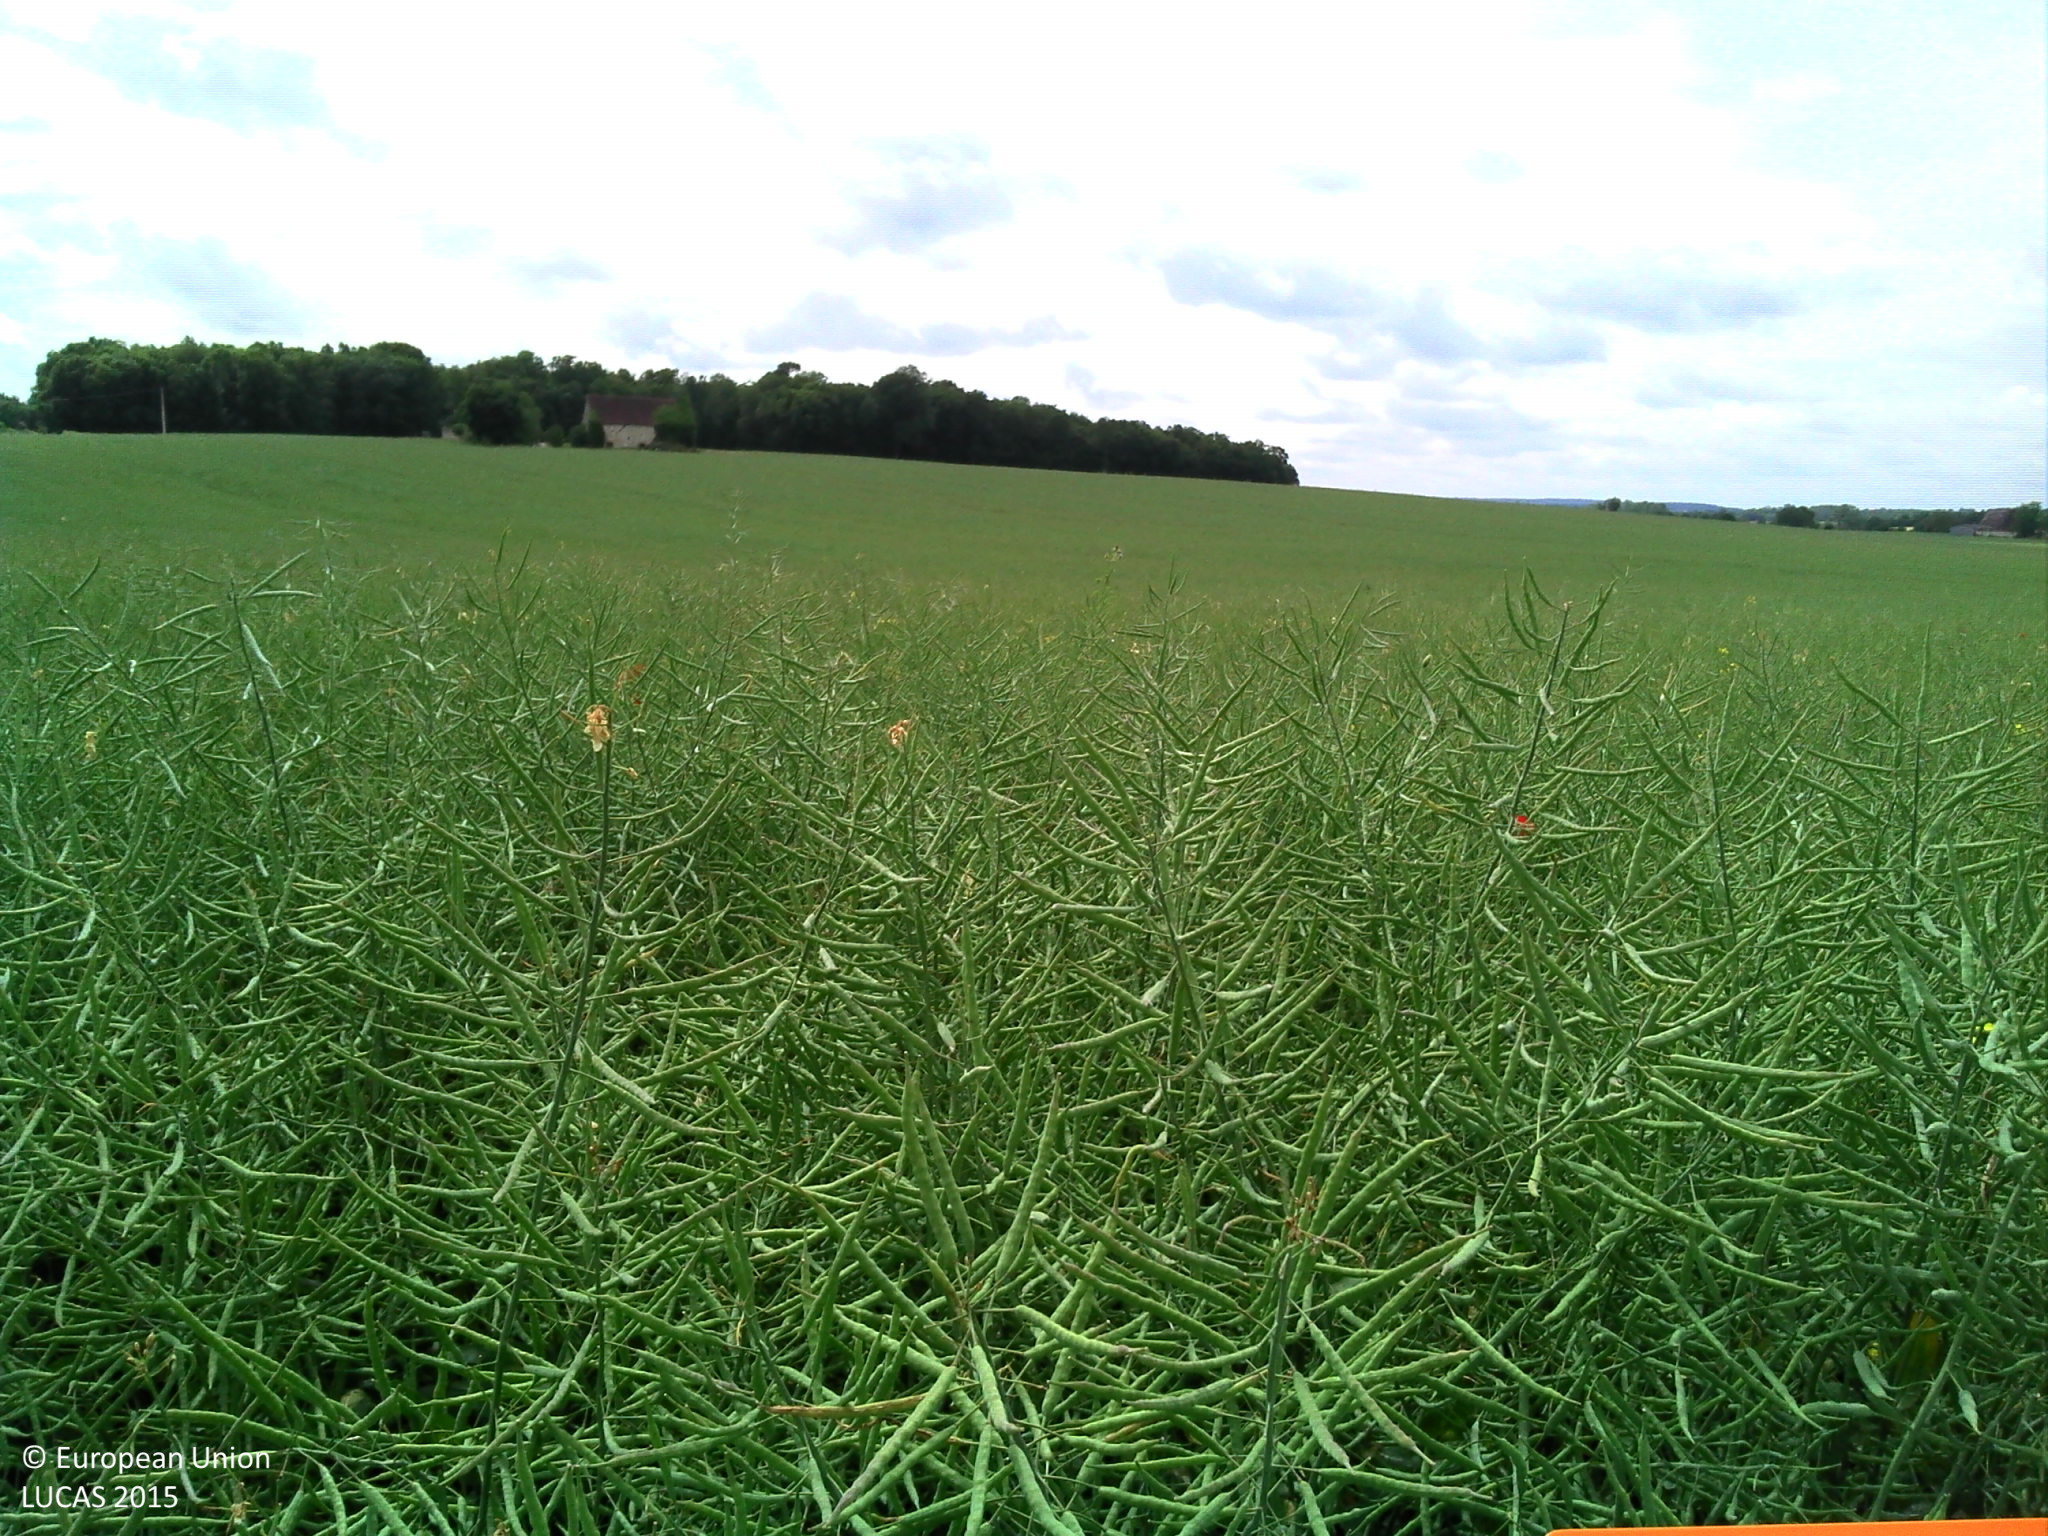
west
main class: Cropland
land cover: Rape and turnip rape
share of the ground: > 75 %
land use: Agriculture (excluding fallow land and kitchen gardens)
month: May
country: FR
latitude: 47.1104
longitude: 2.9183
